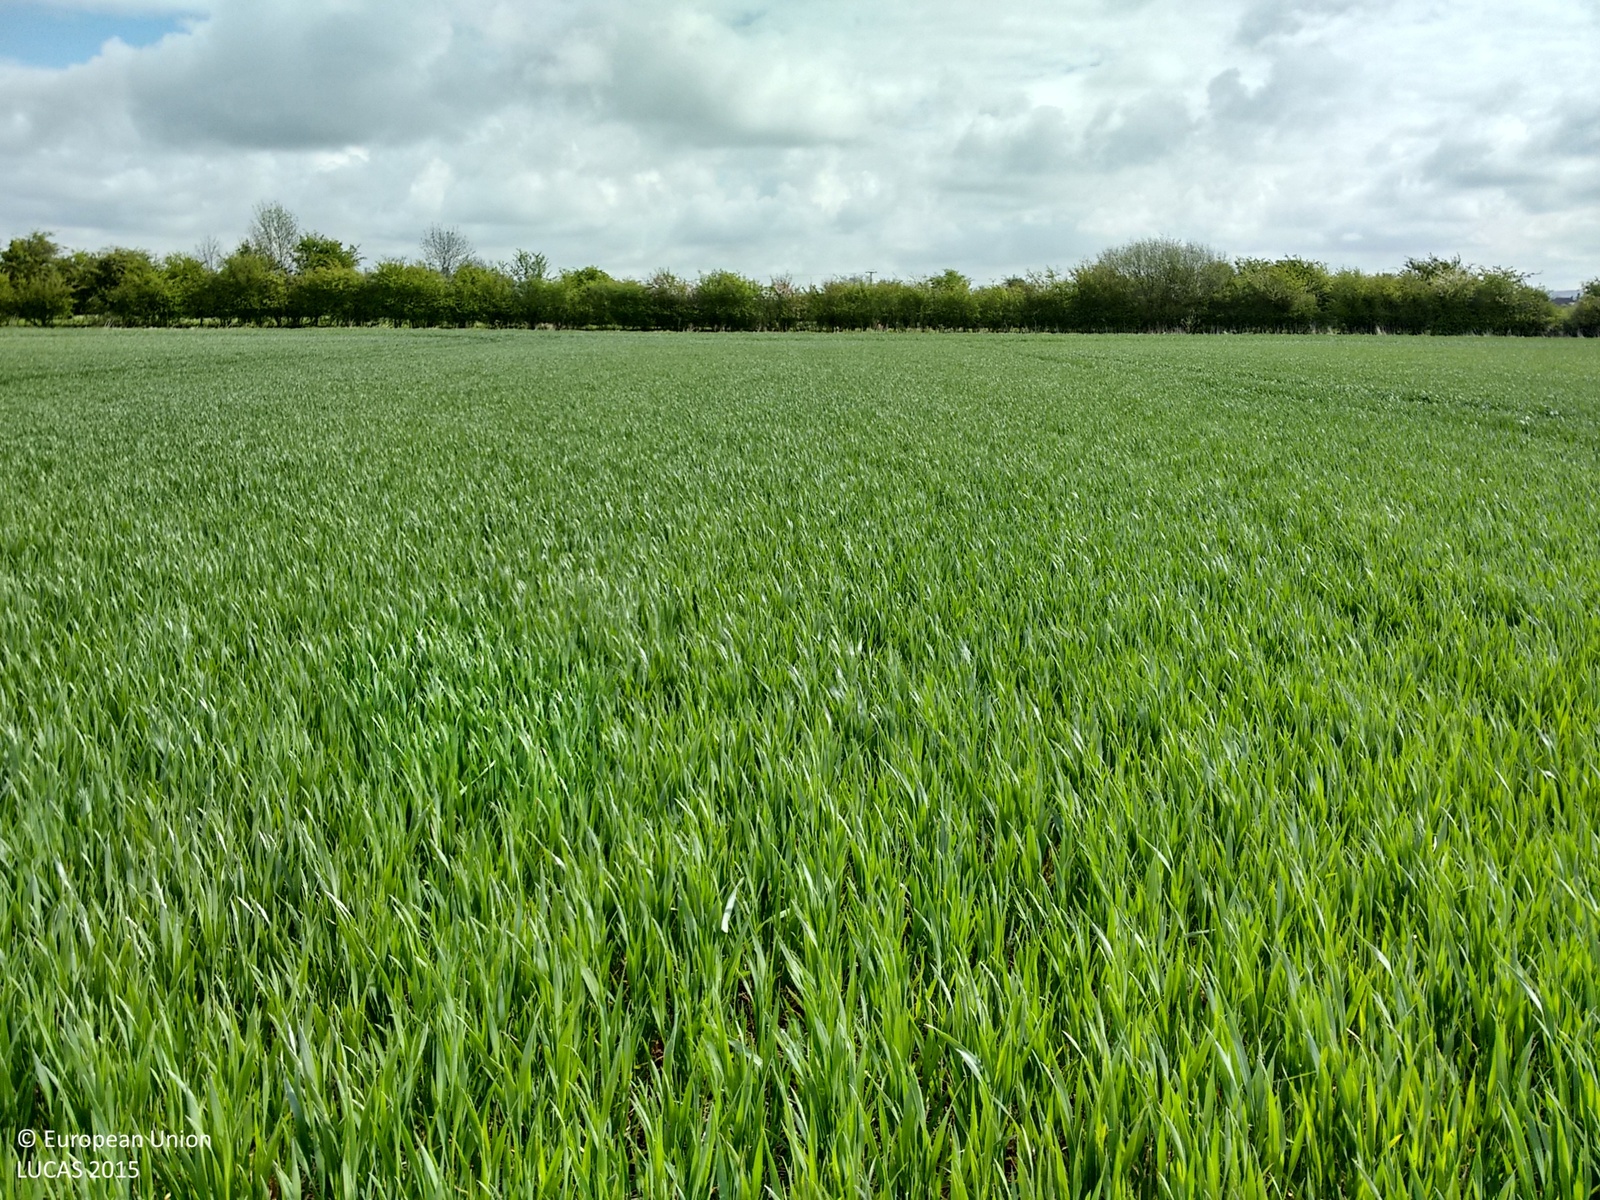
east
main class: Cropland
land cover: Common wheat
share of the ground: > 75 %
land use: Agriculture (excluding fallow land and kitchen gardens)
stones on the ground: 10 - 25 %
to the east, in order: Common wheat; Grass margins; Managed hedges; Tracks; Grass margins; Inland fresh running water; Abandoned hedges; Fences; Grassland without tree/shrub cover
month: May
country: GB
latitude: 51.8780
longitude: -0.6589
